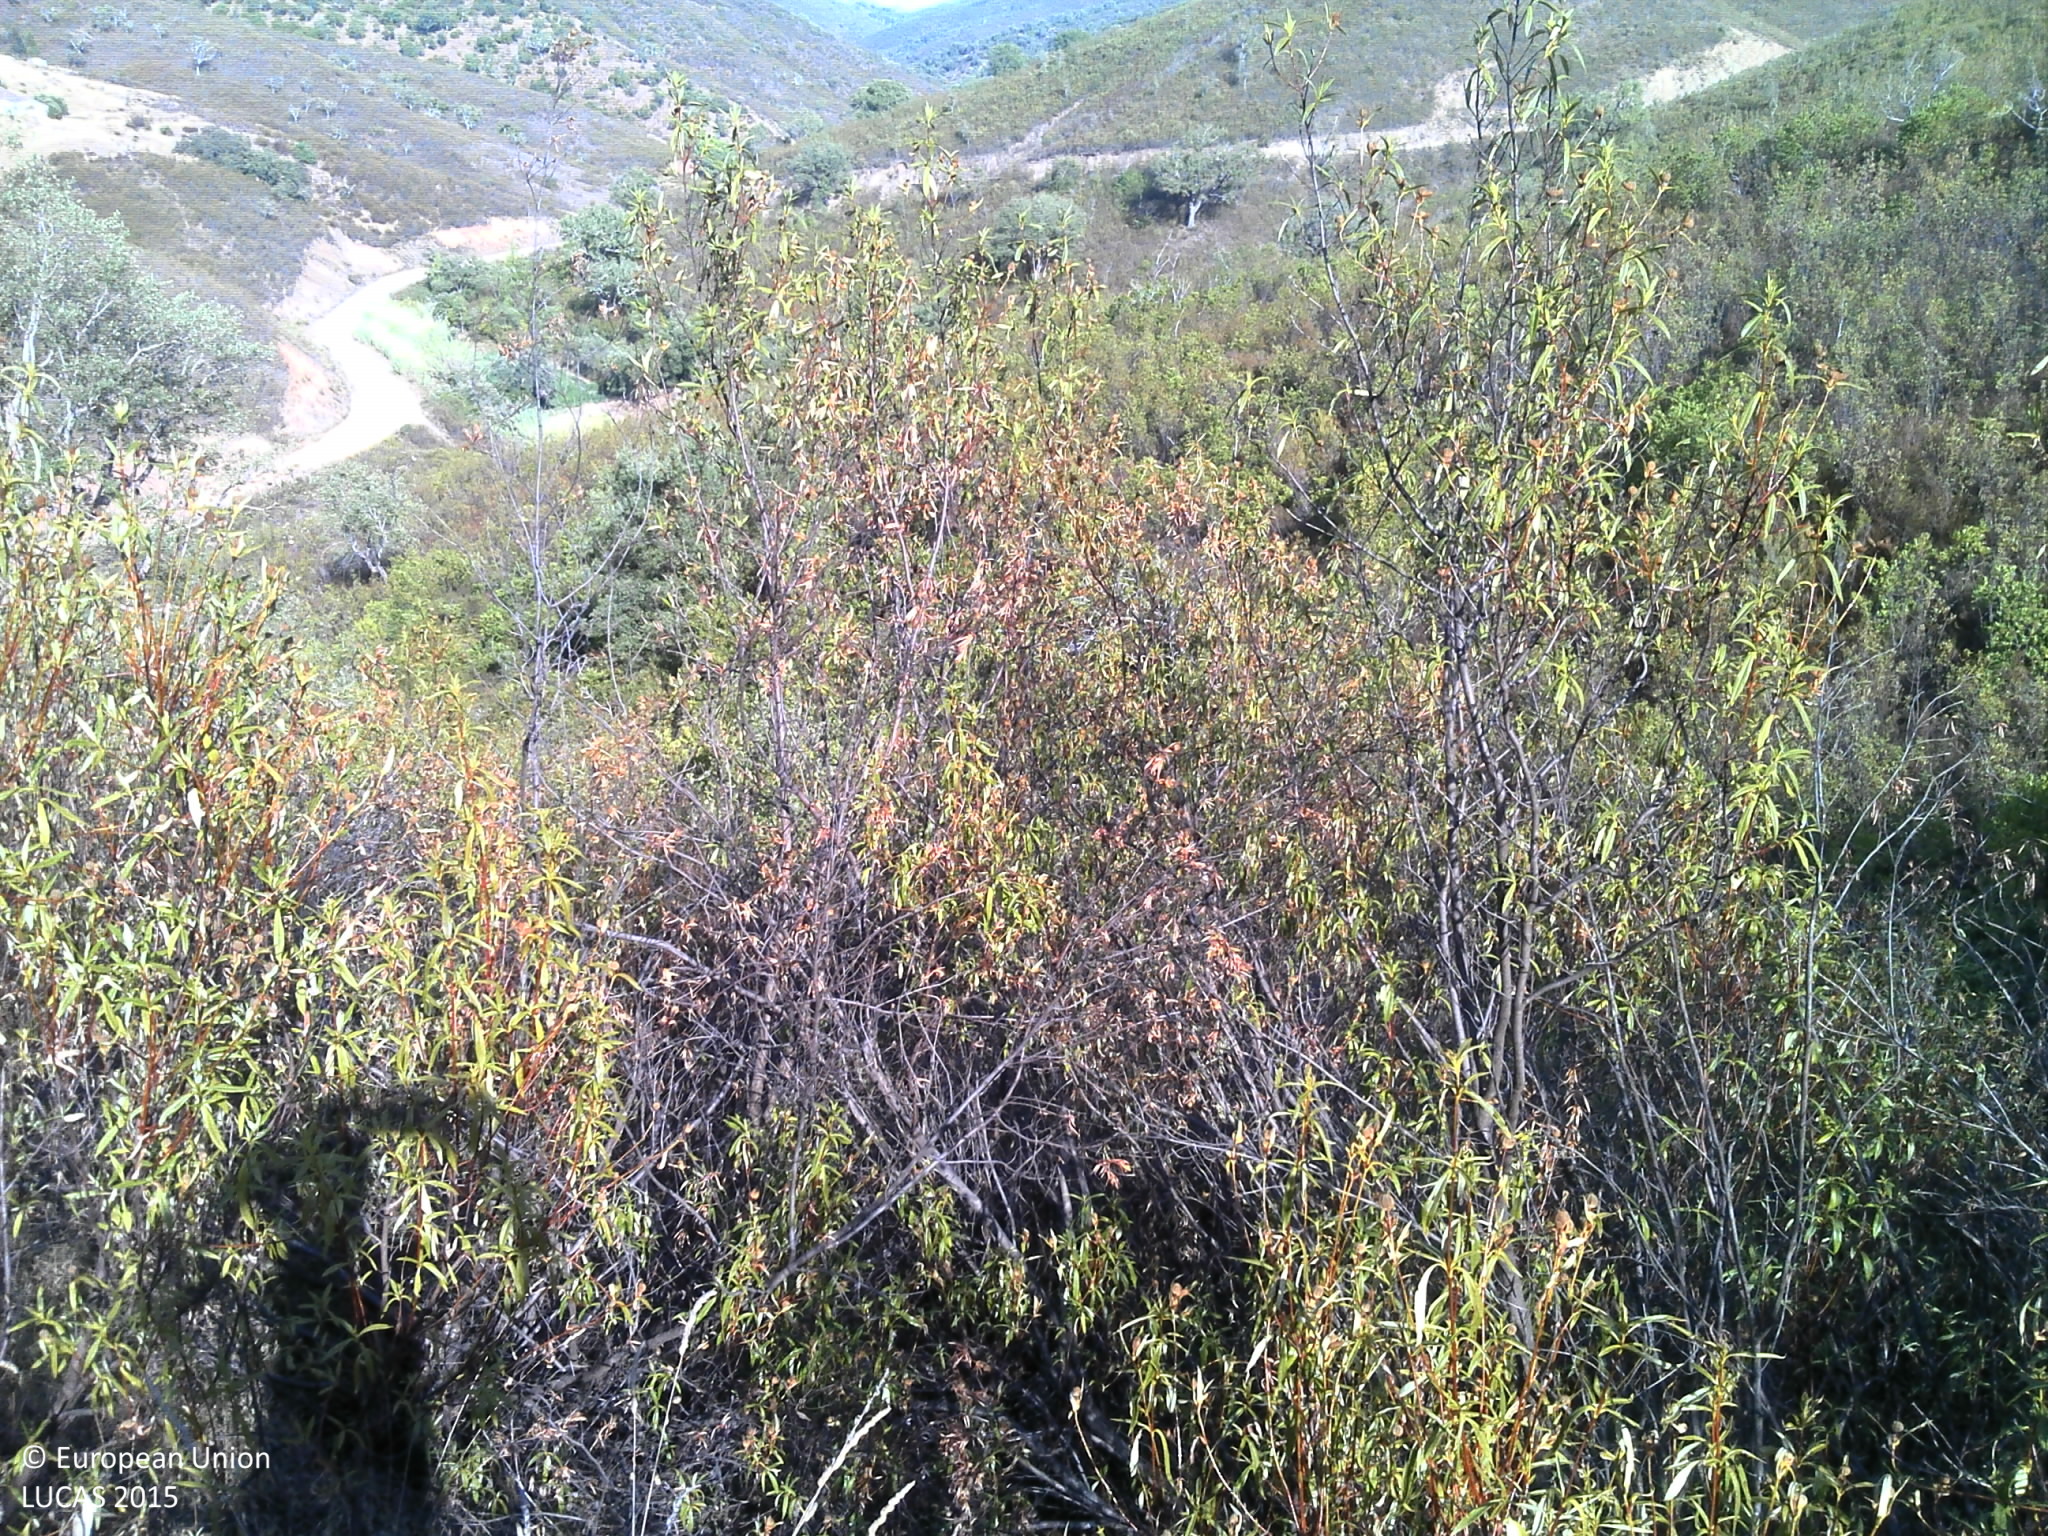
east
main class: Shrubland
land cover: Shrubland without tree cover
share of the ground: > 75 %
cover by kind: shrubs 75 %, herbaceous plants 20 %, unconsolidated bare surface 5 %
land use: Abandoned areas
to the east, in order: Shrubland without tree cover; Rivers and streams; Shrubland with sparse tree cover; Rivers and streams; Shrubland with sparse tree cover; Other bare soil
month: September
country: PT
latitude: 37.3355
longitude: -8.1585
